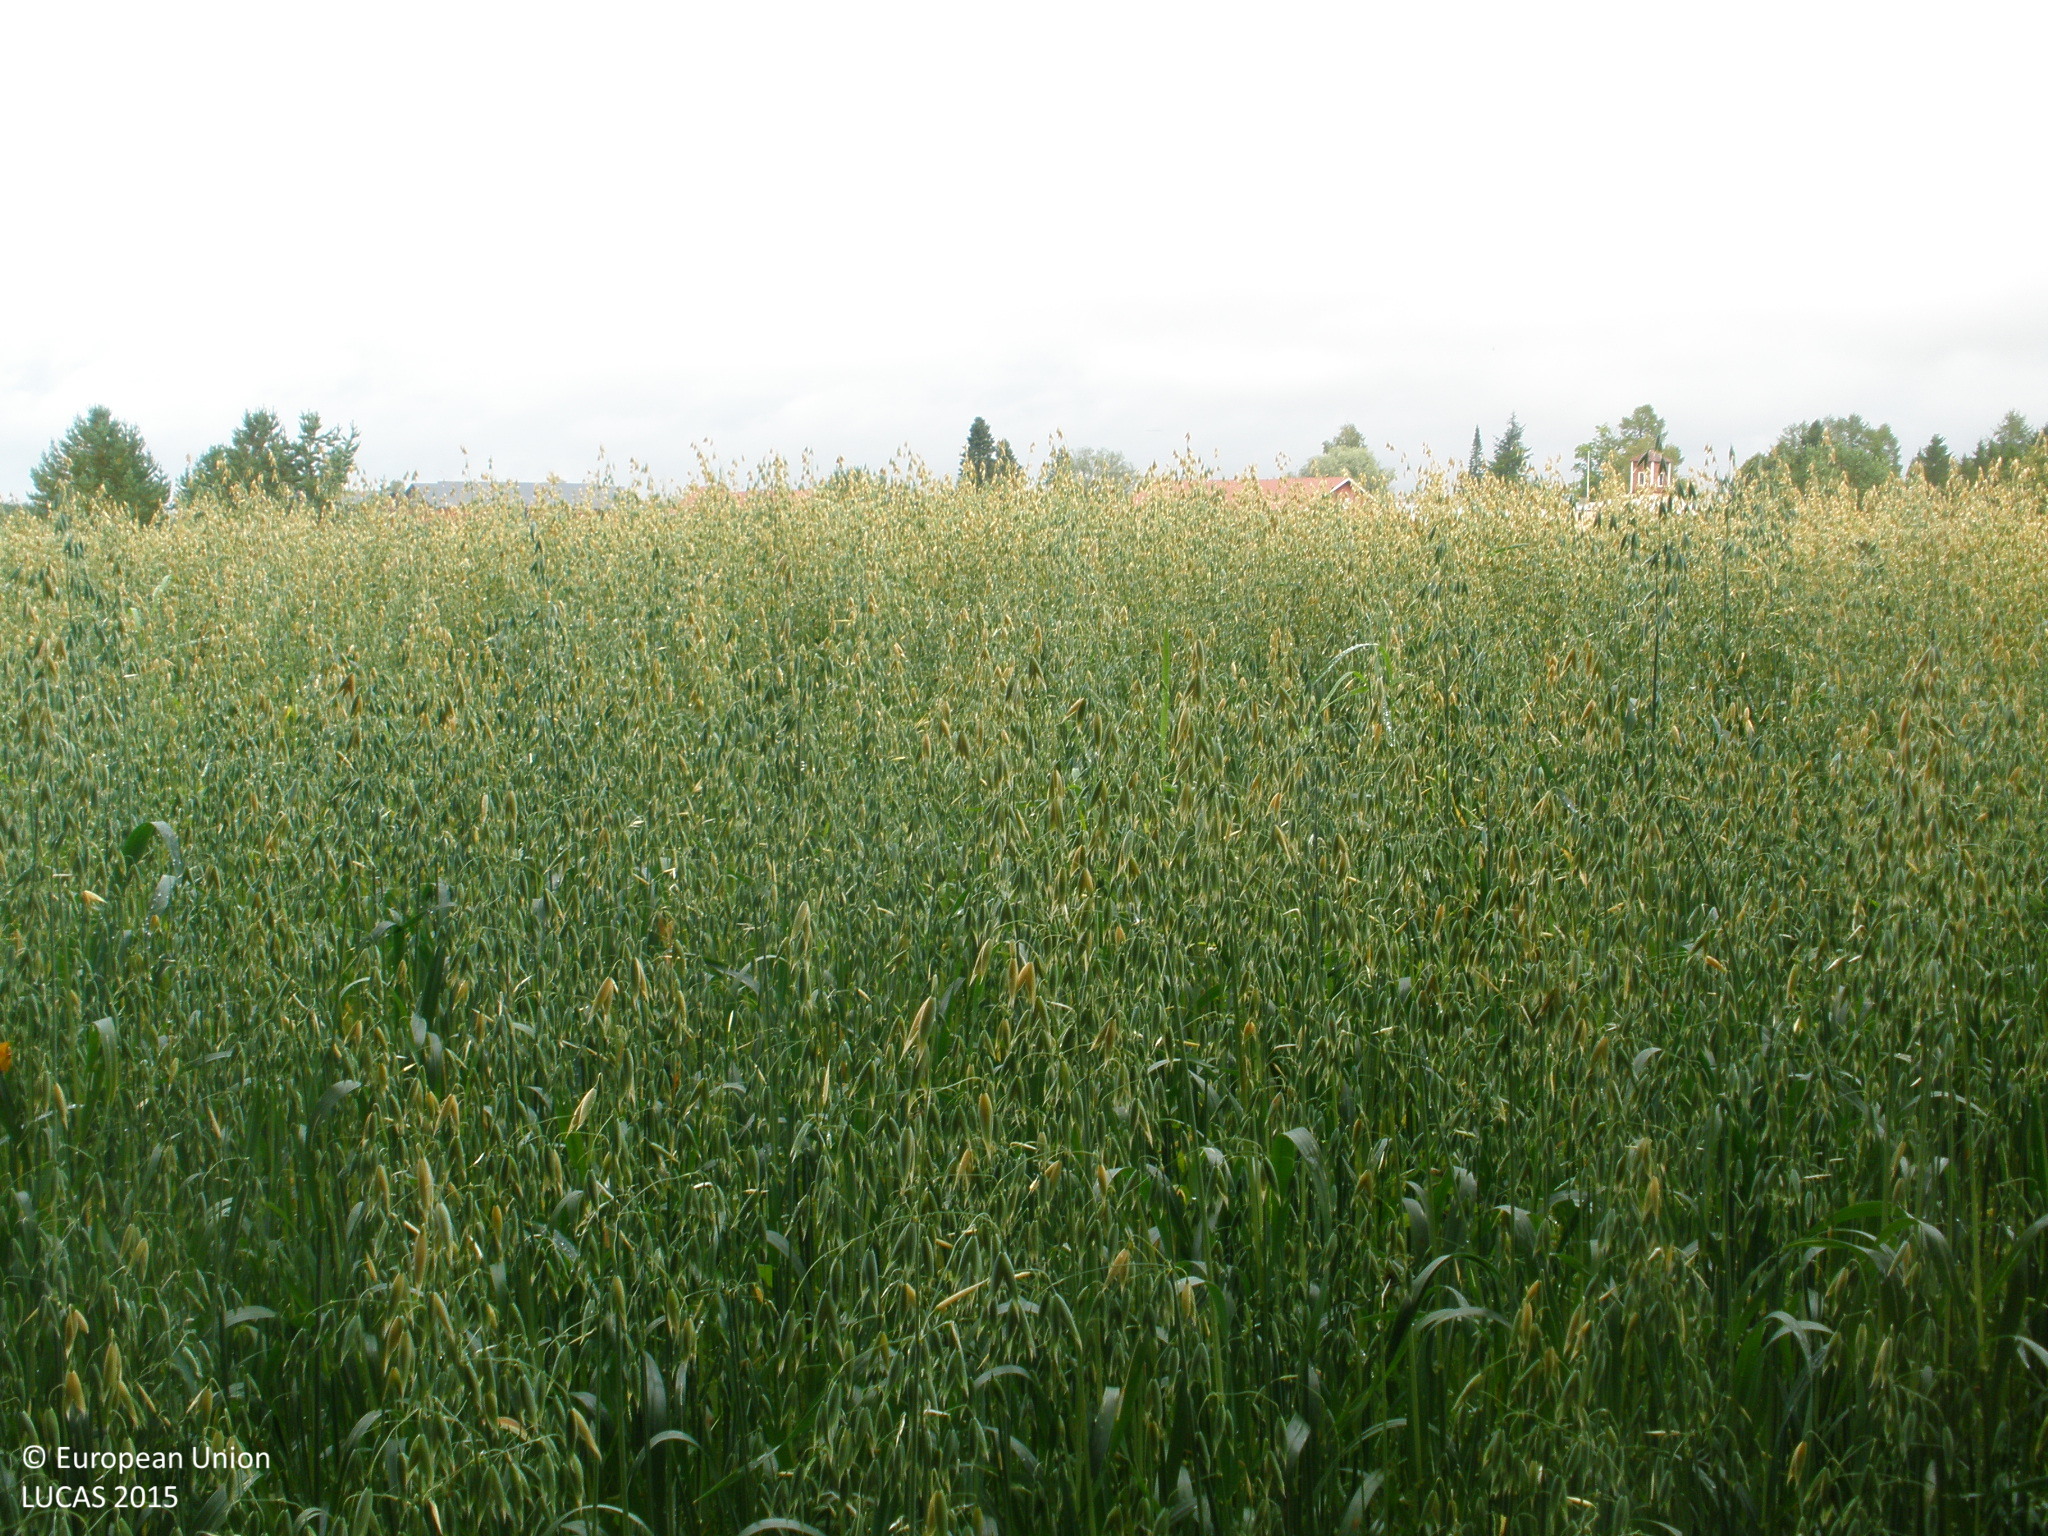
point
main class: Cropland
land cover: Oats
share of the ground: > 75 %
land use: Agriculture (excluding fallow land and kitchen gardens)
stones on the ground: < 10 %
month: August
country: FI
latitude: 60.4868
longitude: 23.4246
